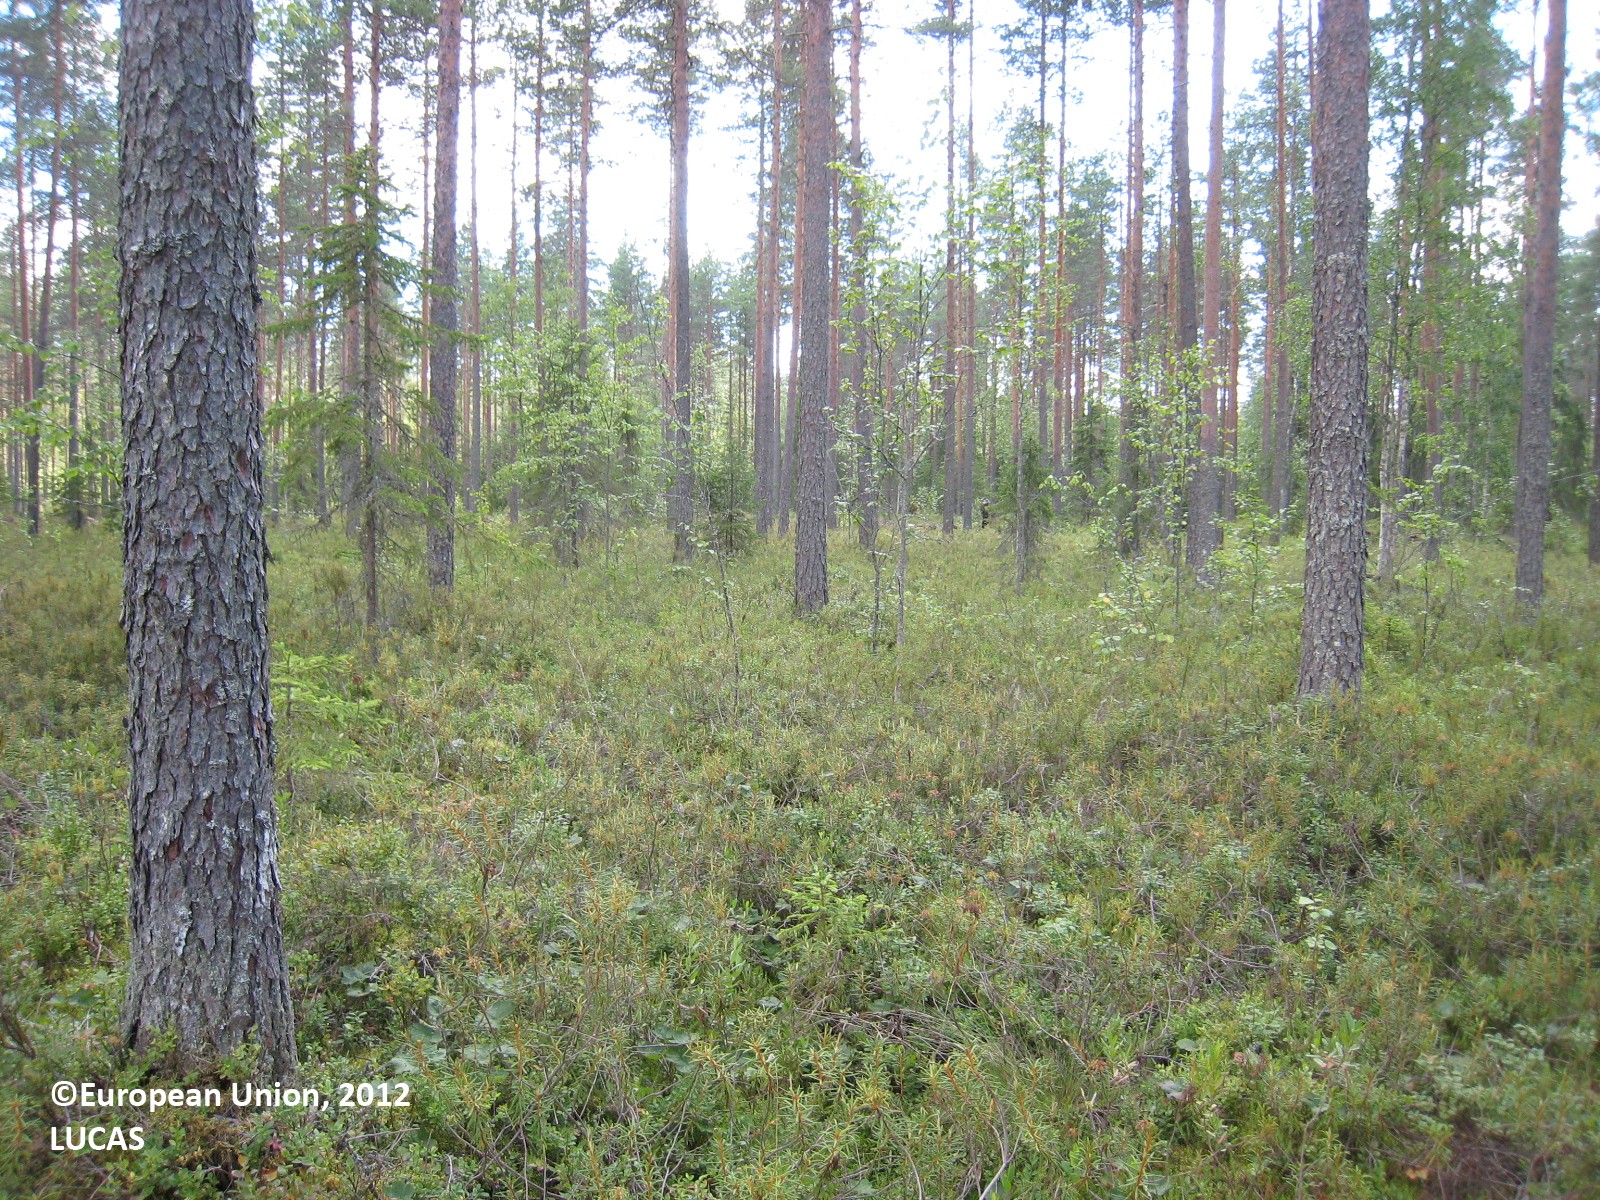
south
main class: Woodland
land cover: Pine dominated coniferous woodland
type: mire and swamp forests
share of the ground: 25 - 50 %
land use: Forestry
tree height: > 5 m
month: July
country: FI
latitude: 62.6546
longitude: 27.3121
